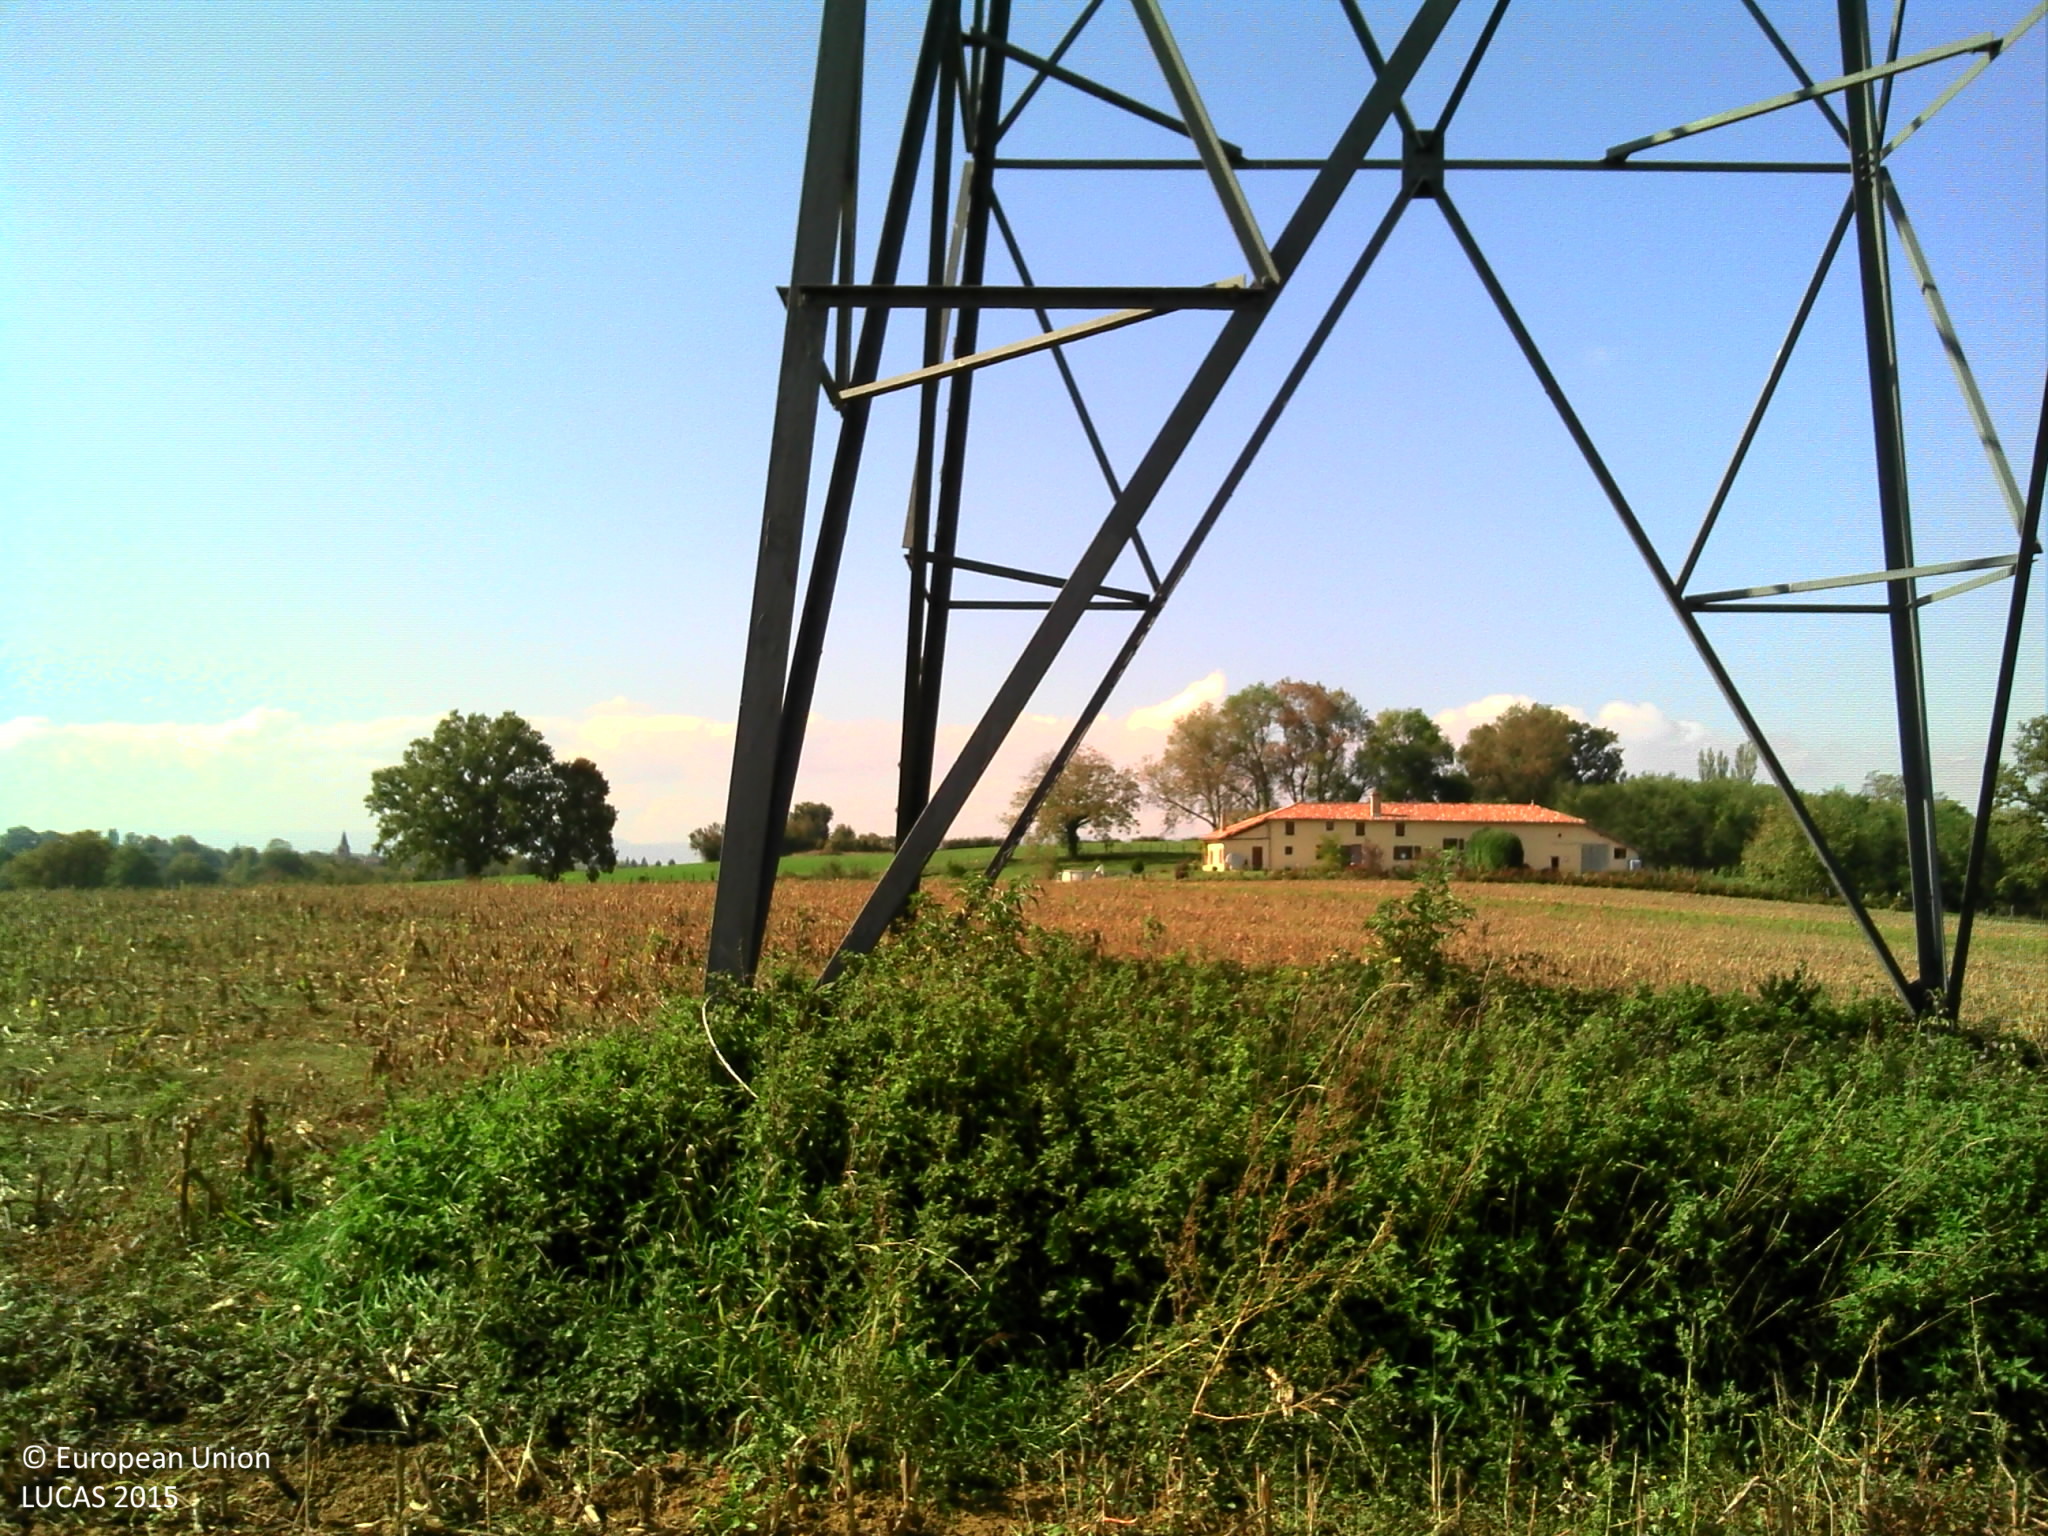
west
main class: Cropland
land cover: Maize
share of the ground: < 10 %
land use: Agriculture (excluding fallow land and kitchen gardens)
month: October
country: FR
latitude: 46.2479
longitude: 4.9051
